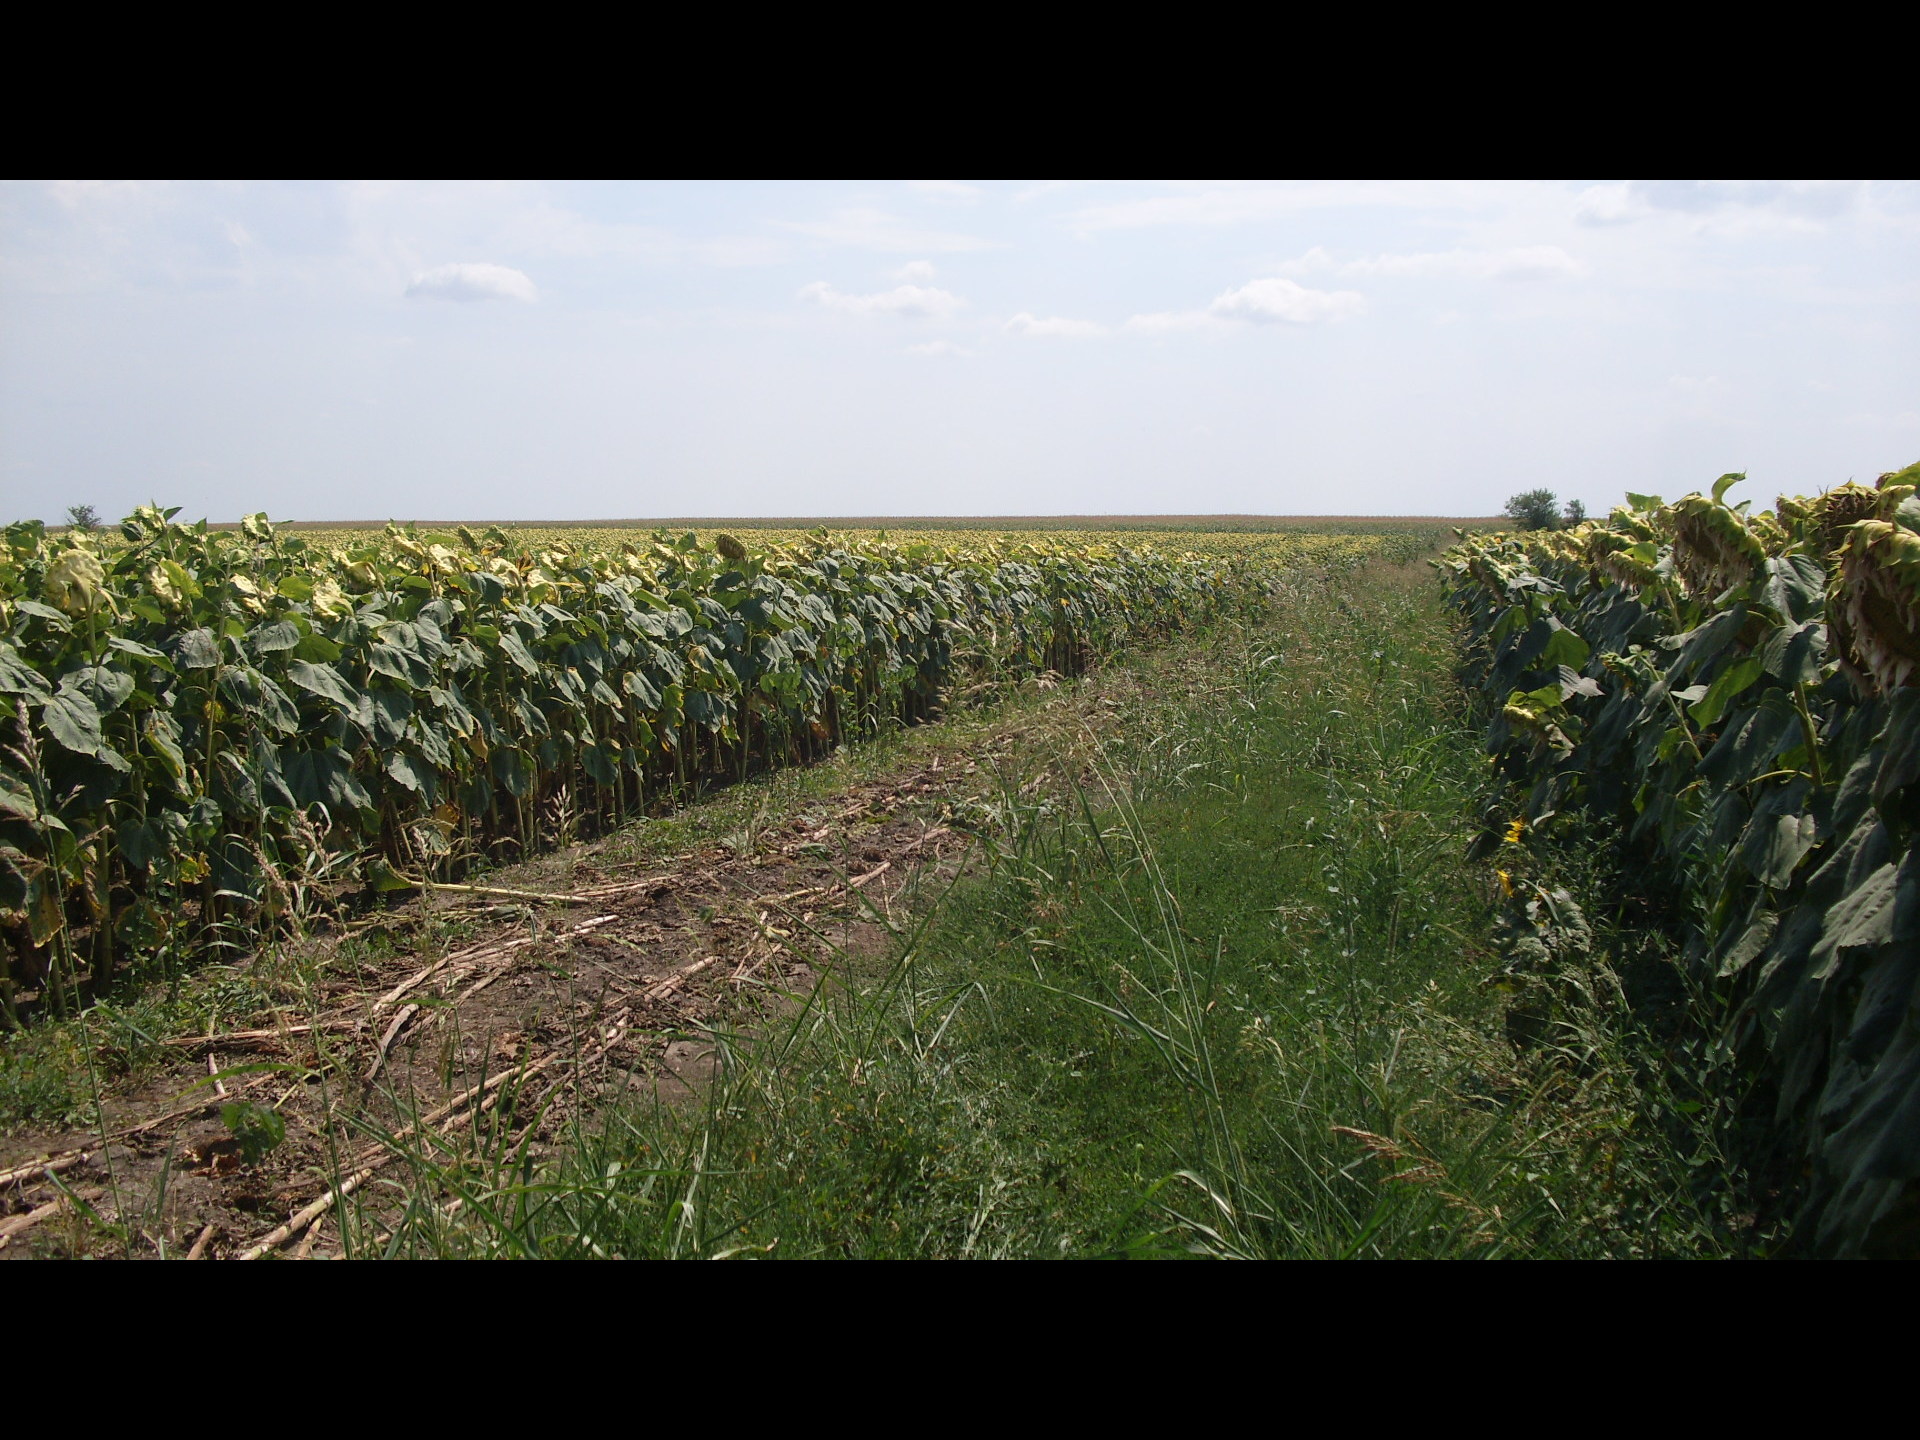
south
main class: Cropland
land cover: Sunflower
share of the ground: > 75 %
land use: Agriculture (excluding fallow land and kitchen gardens)
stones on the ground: < 10 %
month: July
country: BG
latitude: 43.7610
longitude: 23.6000
